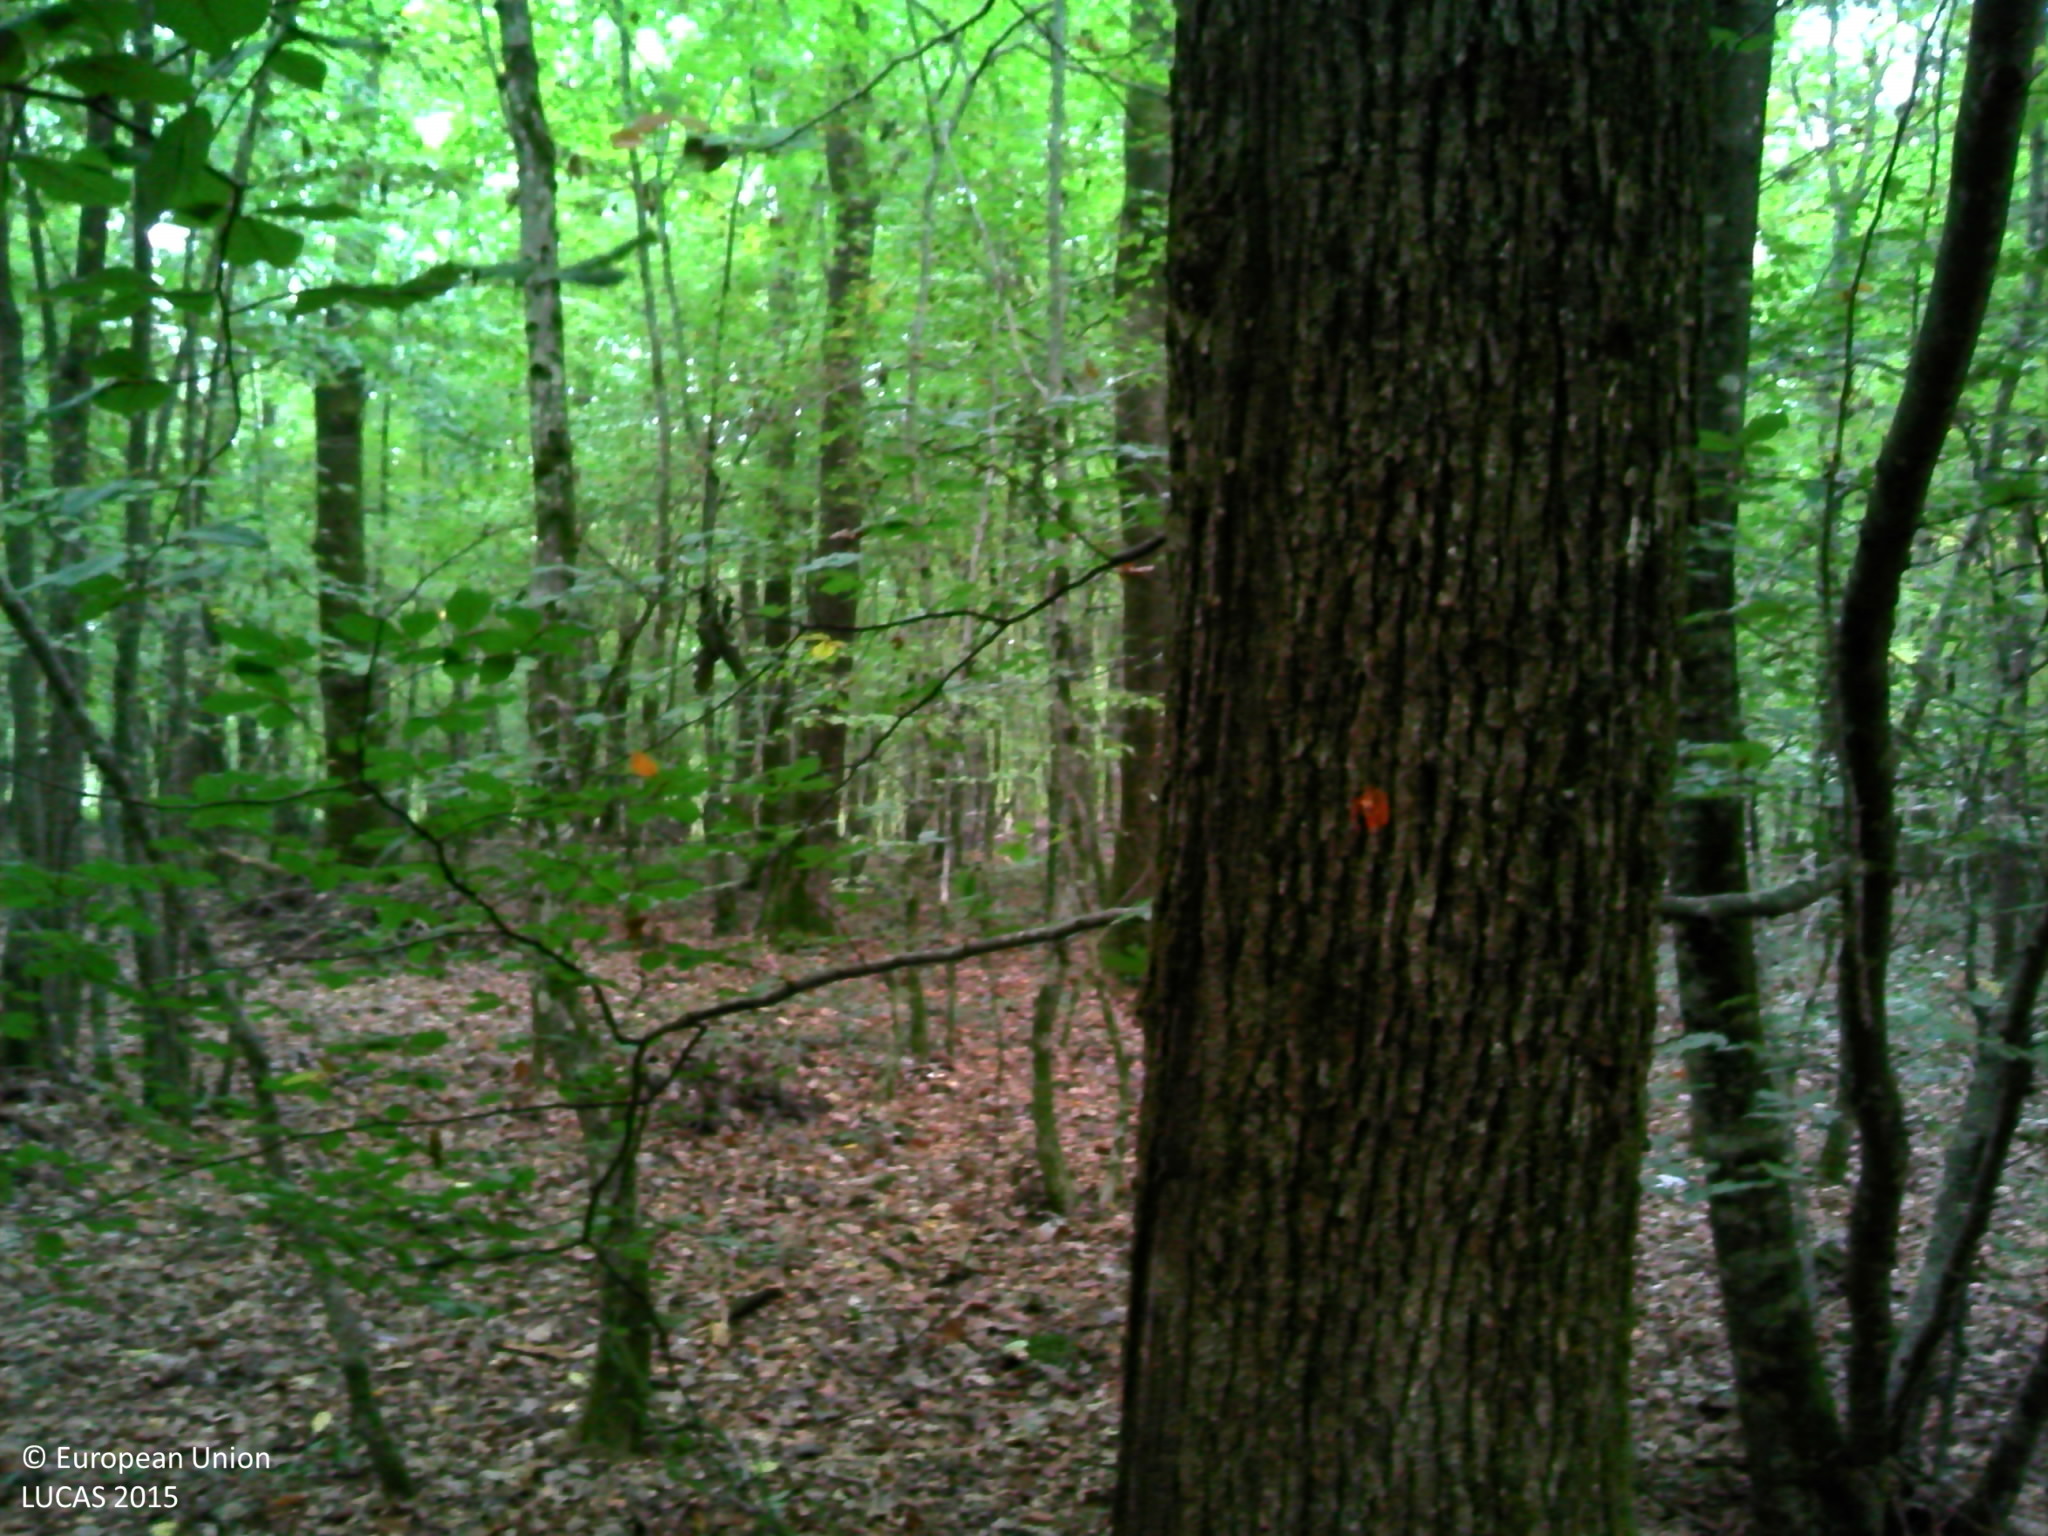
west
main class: Woodland
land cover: Broadleaved woodland
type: acidophilous oak and oak-birch forest
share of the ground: > 75 %
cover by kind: broadleaved forest trees 90 %, herbaceous plants 5 %, lichens and mosses 5 %
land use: Forestry
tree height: > 5 m
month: October
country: FR
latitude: 46.2286
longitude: 5.2704
